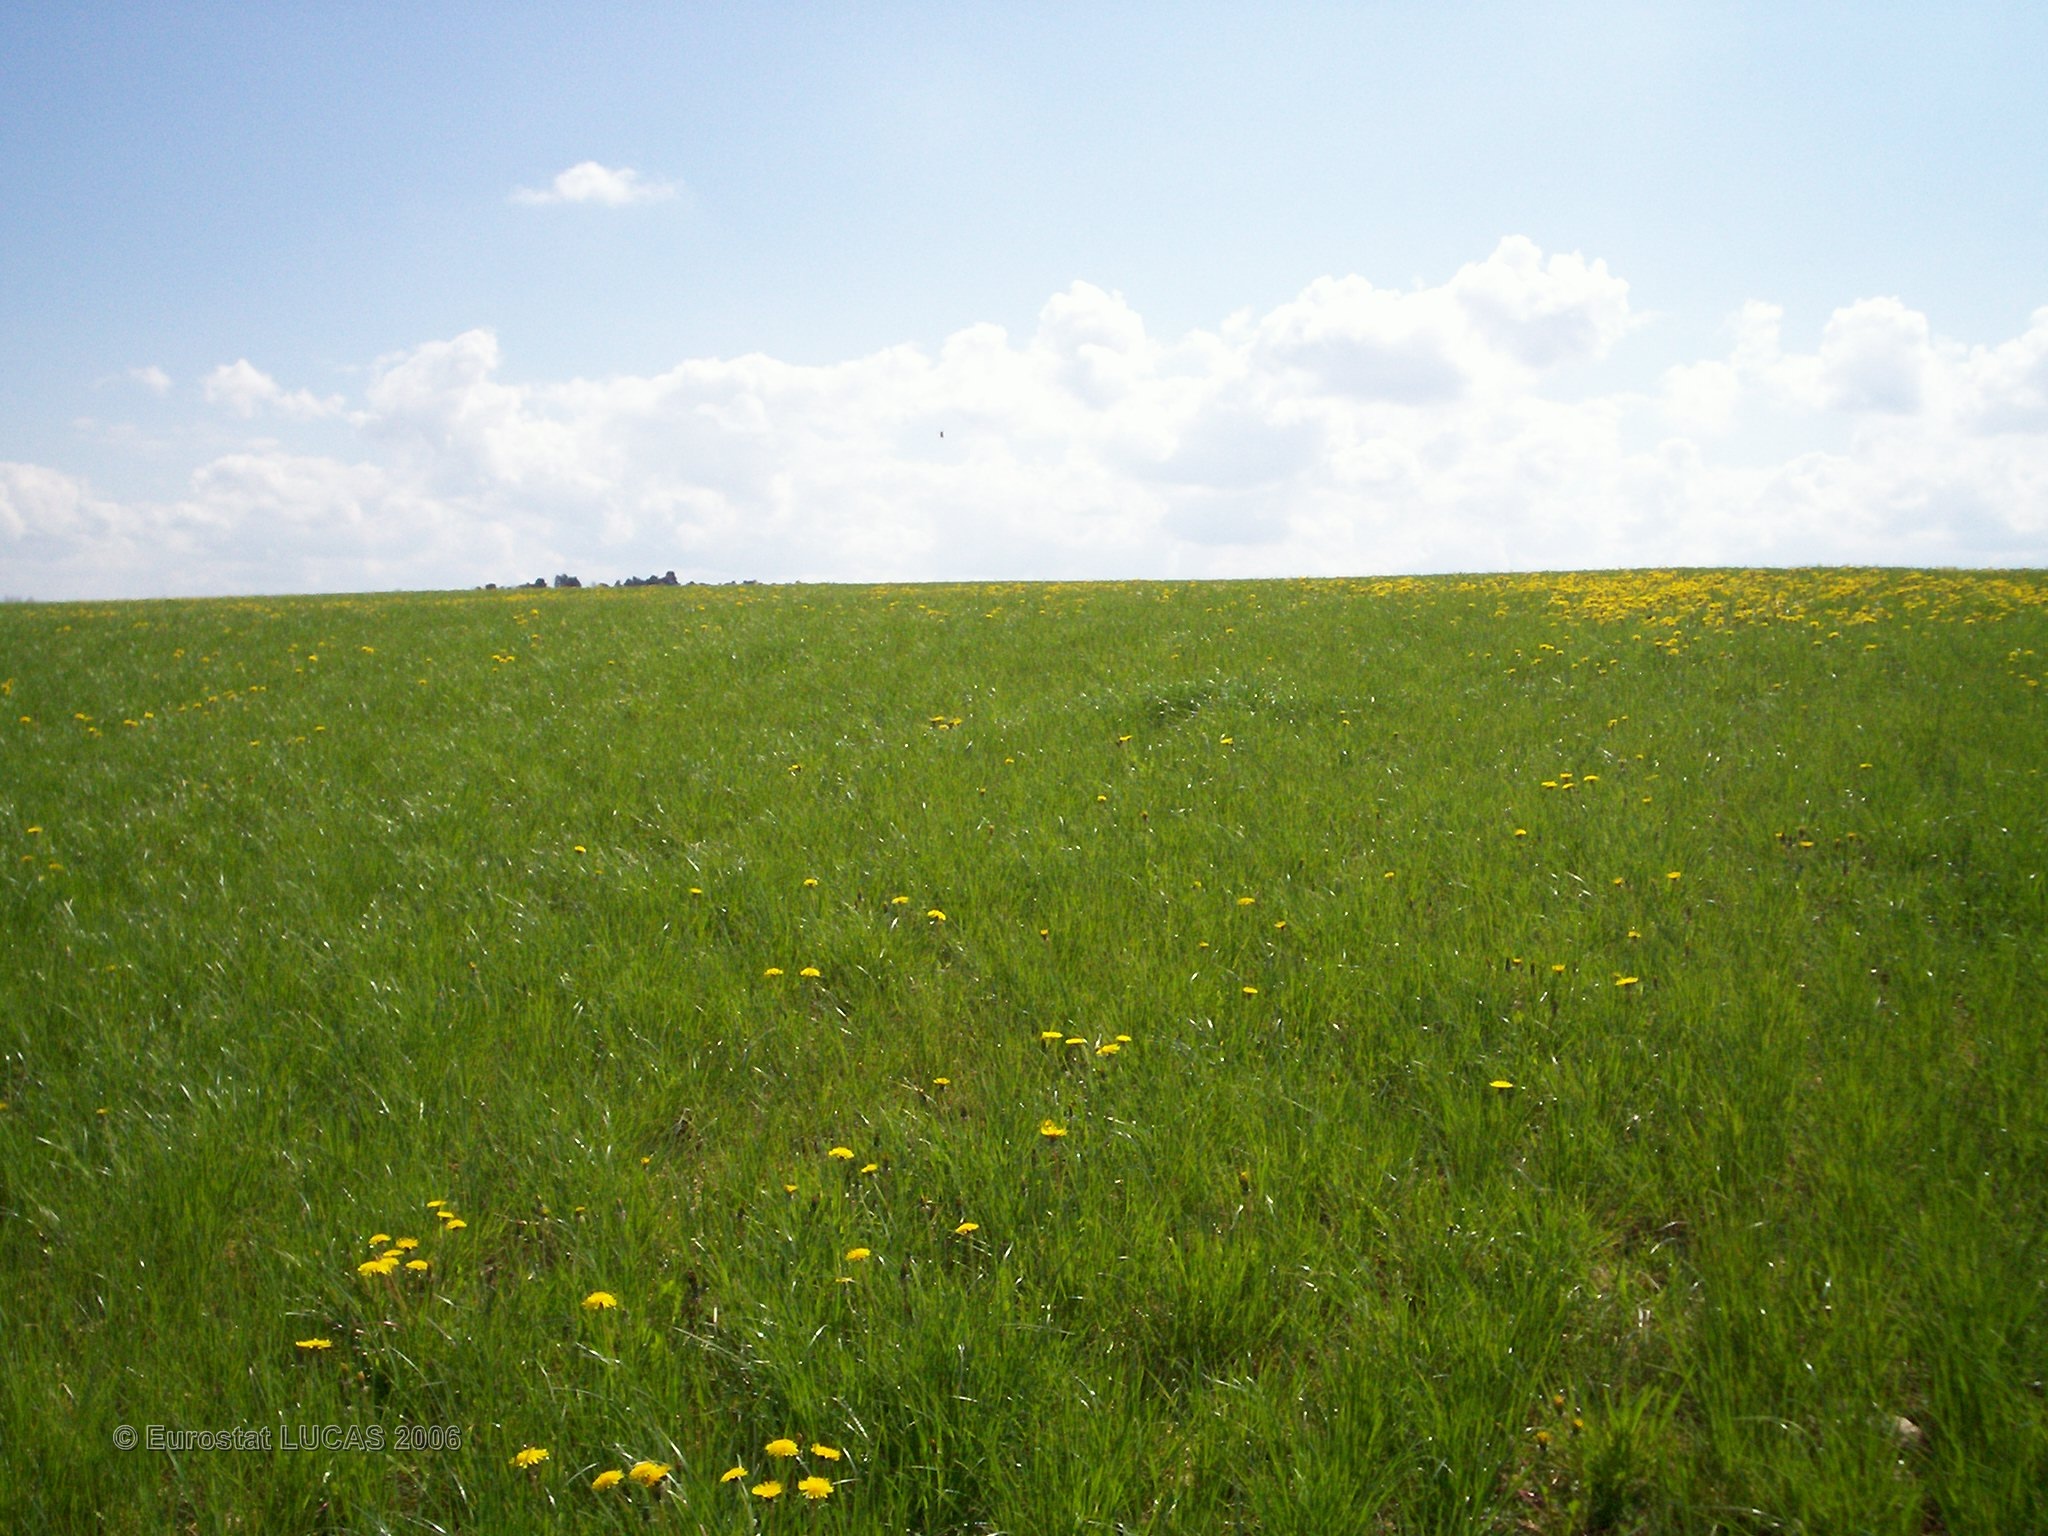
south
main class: Grassland
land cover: Grassland without tree/shrub cover
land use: Agriculture (excluding fallow land and kitchen gardens)
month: April
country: FR
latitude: 47.6985
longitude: 3.9876
